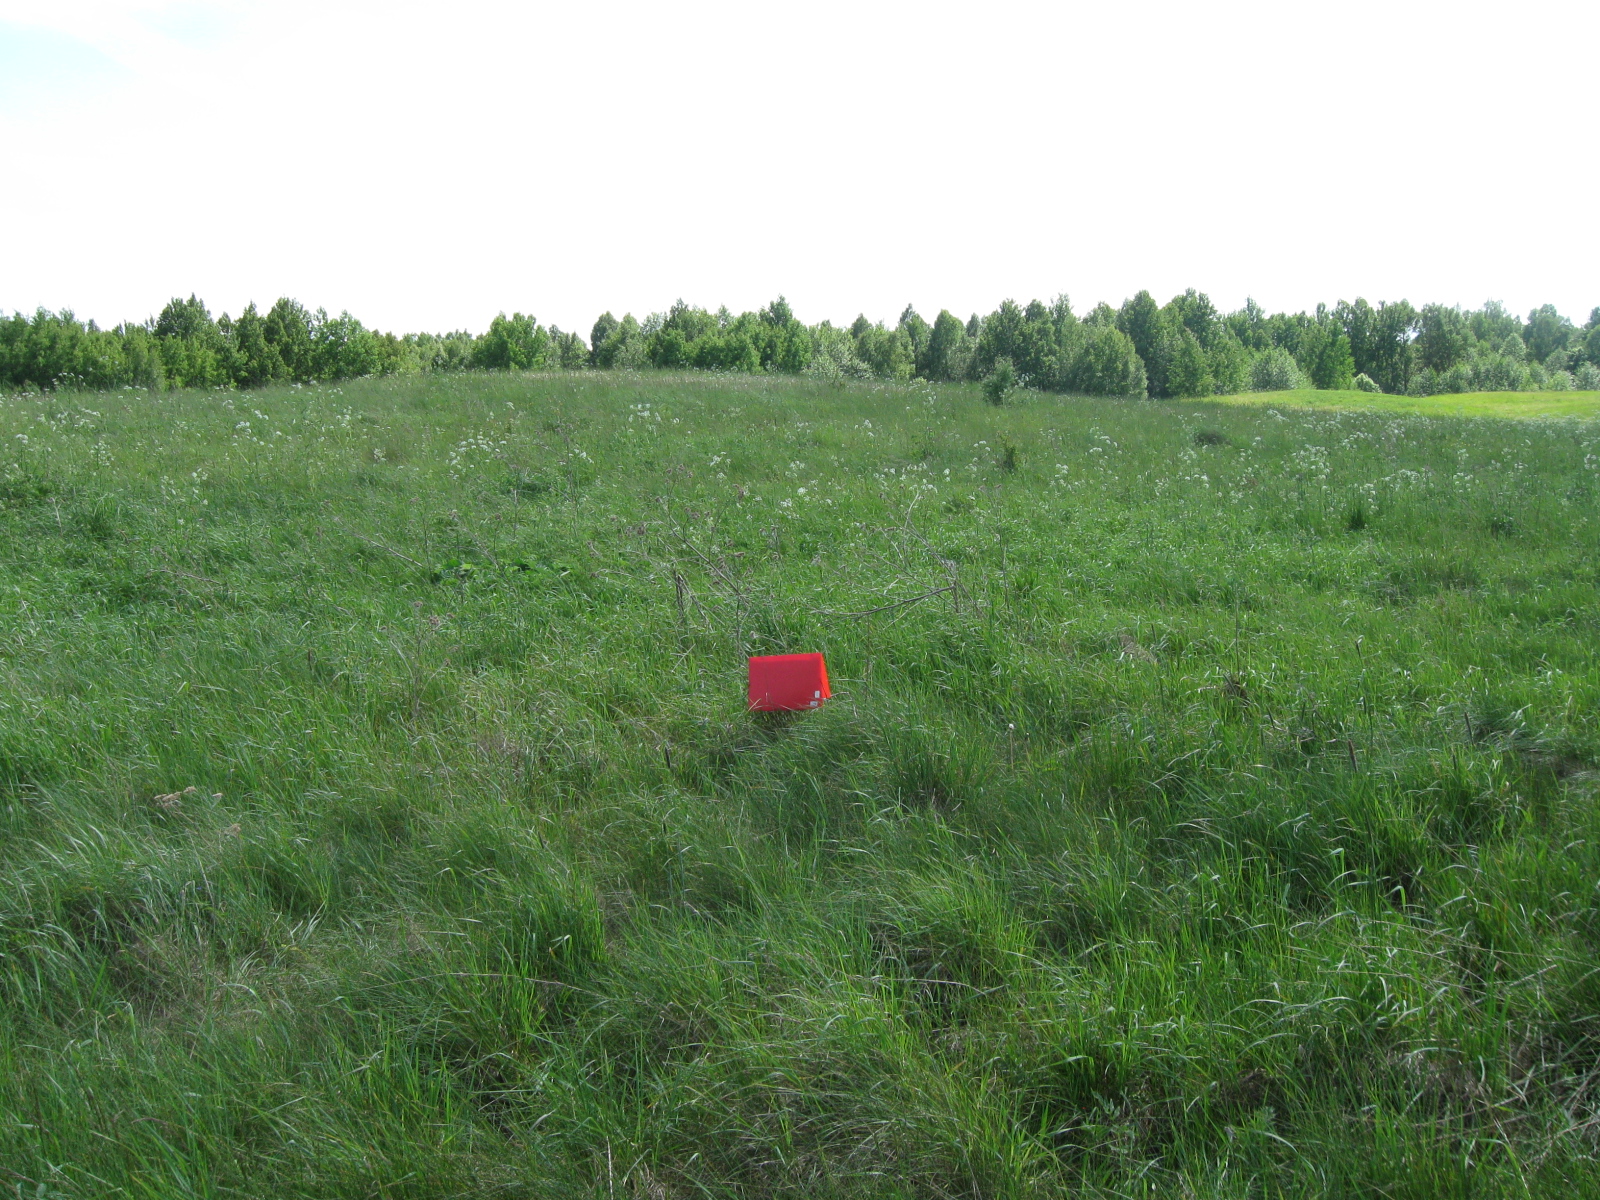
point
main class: Grassland
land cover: Grassland without tree/shrub cover
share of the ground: > 75 %
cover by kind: herbaceous plants 95 %, consolidated bare surface 5 %
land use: Agriculture (excluding fallow land and kitchen gardens)
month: May
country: LT
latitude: 54.2624
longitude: 23.3595
